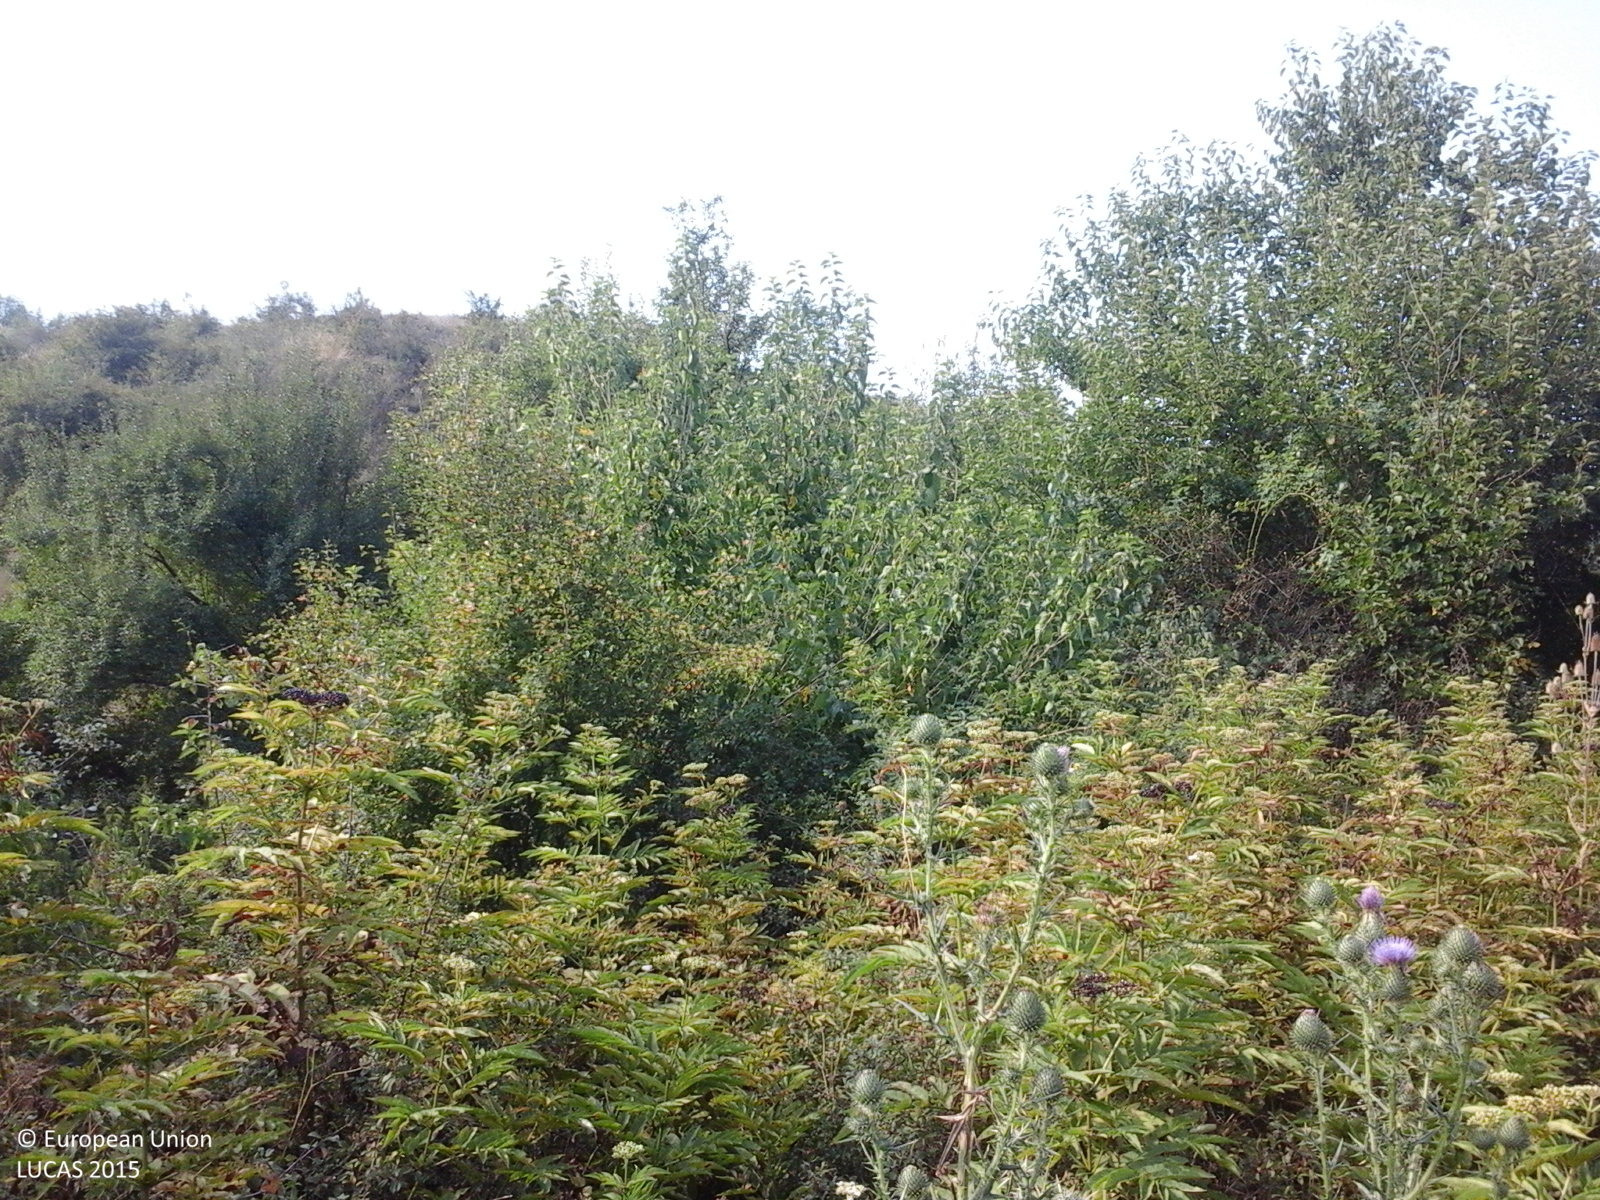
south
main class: Grassland
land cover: Grassland with sparse tree/shrub cover
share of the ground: > 75 %
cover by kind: herbaceous plants 85 %, shrubs 10 %, broadleaved forest trees 5 %
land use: Semi-natural and natural areas not in use
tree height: > 5 m
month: August
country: RO
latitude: 44.5738
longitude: 23.6696
